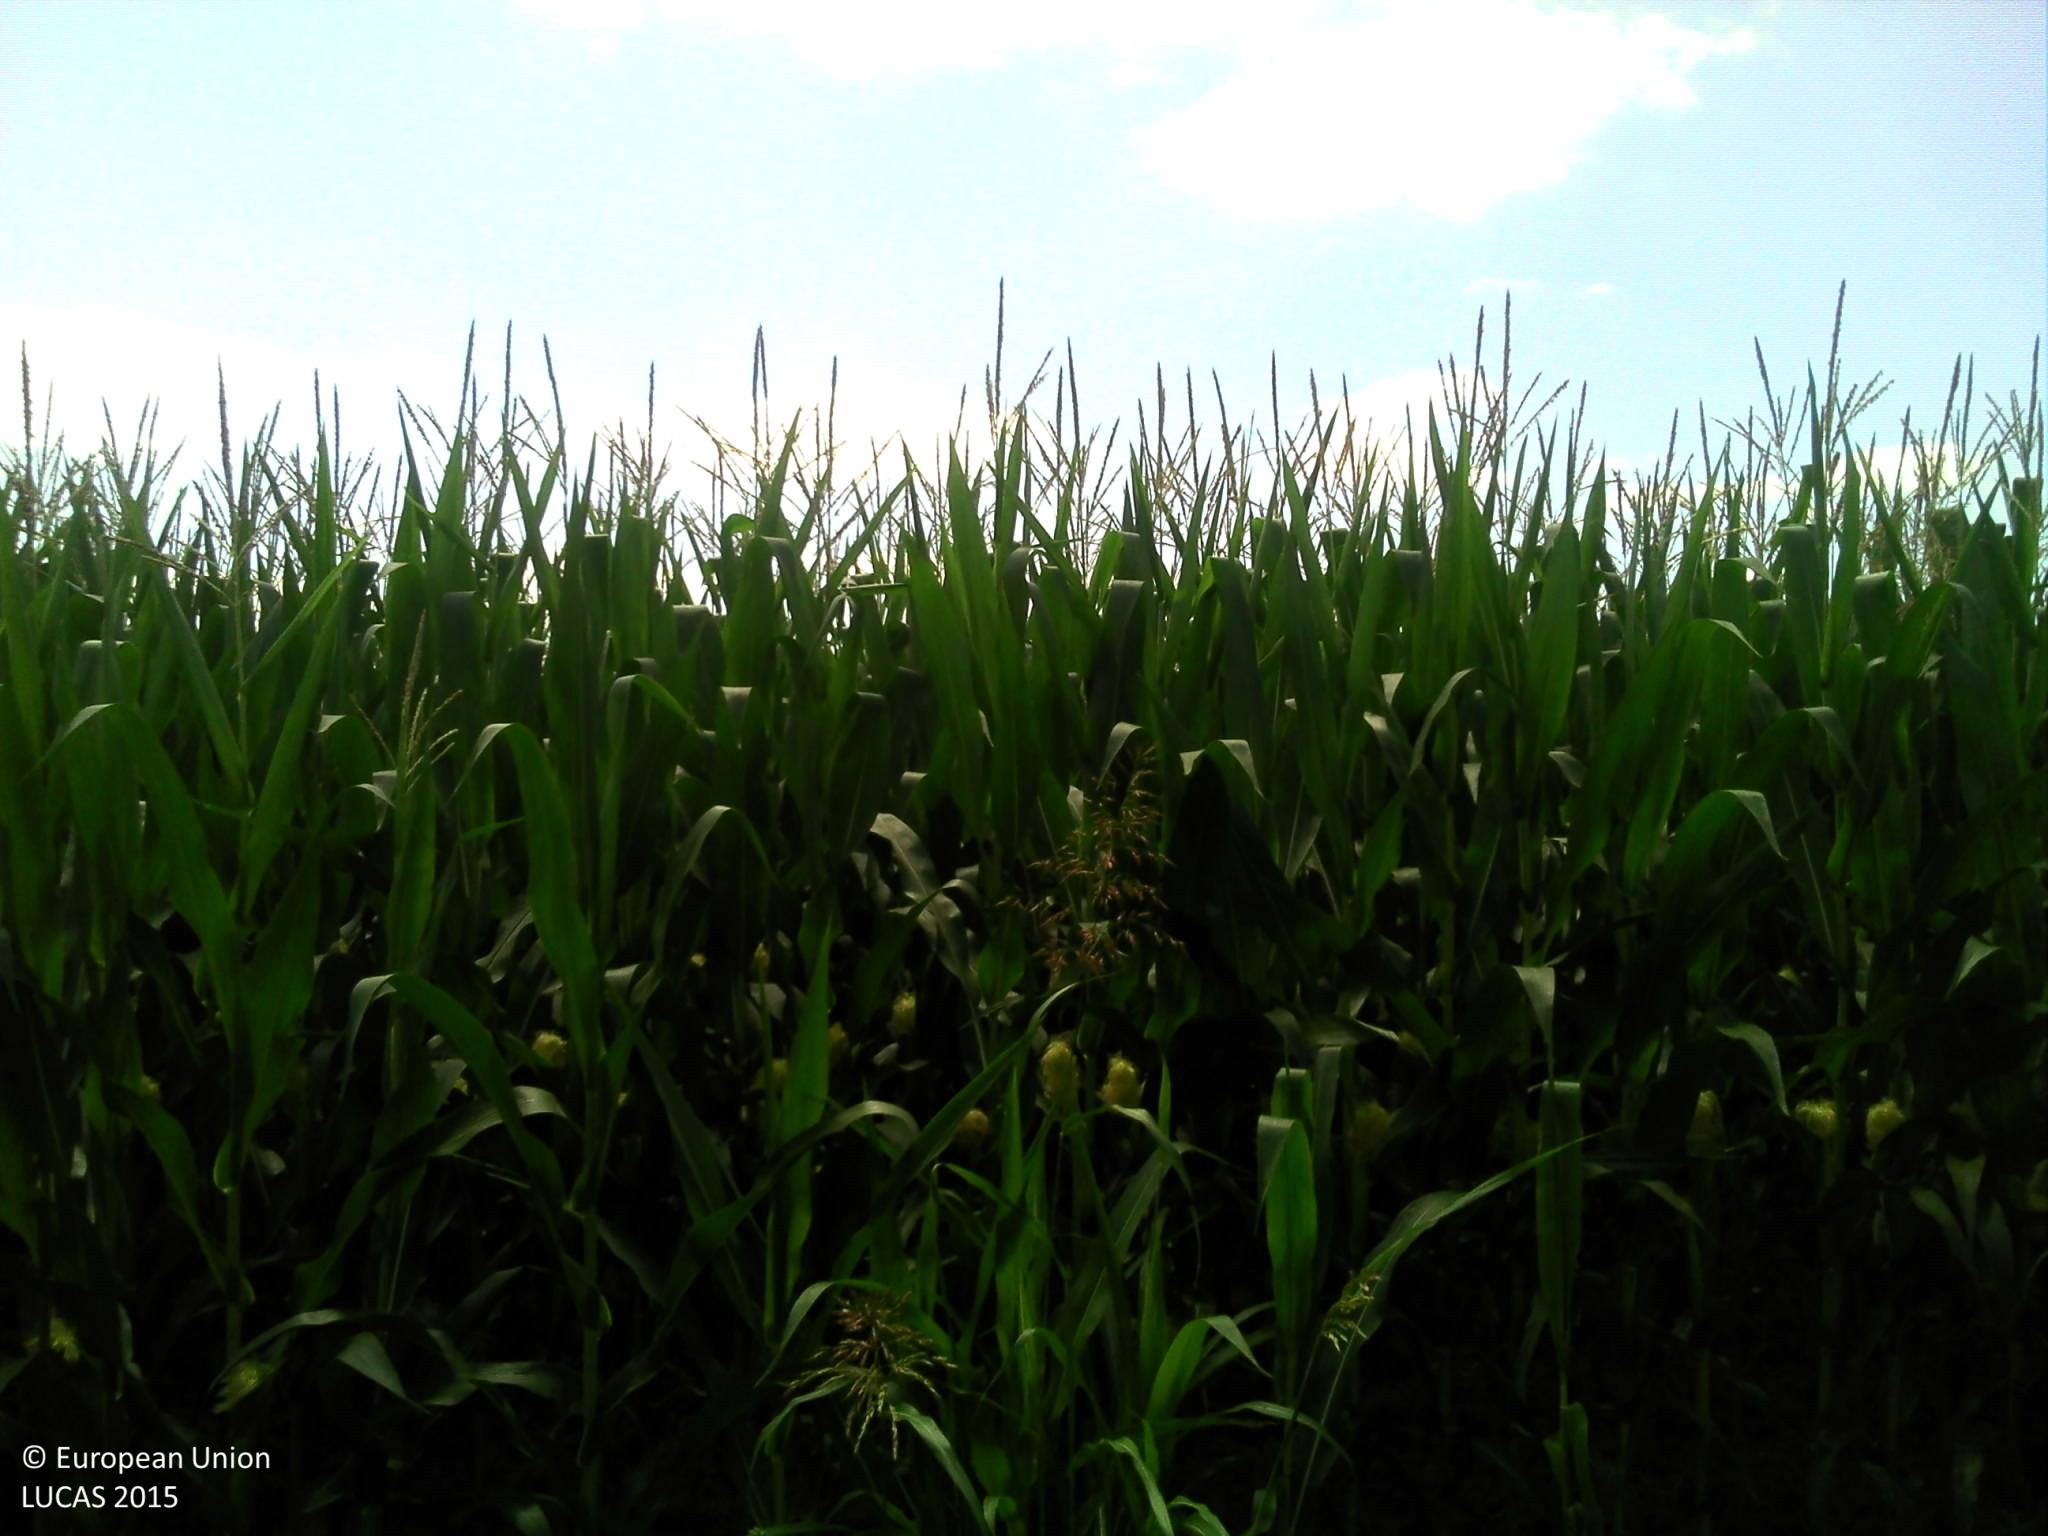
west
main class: Cropland
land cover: Maize
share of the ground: > 75 %
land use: Agriculture (excluding fallow land and kitchen gardens)
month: July
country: FR
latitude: 43.5332
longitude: -1.1147
